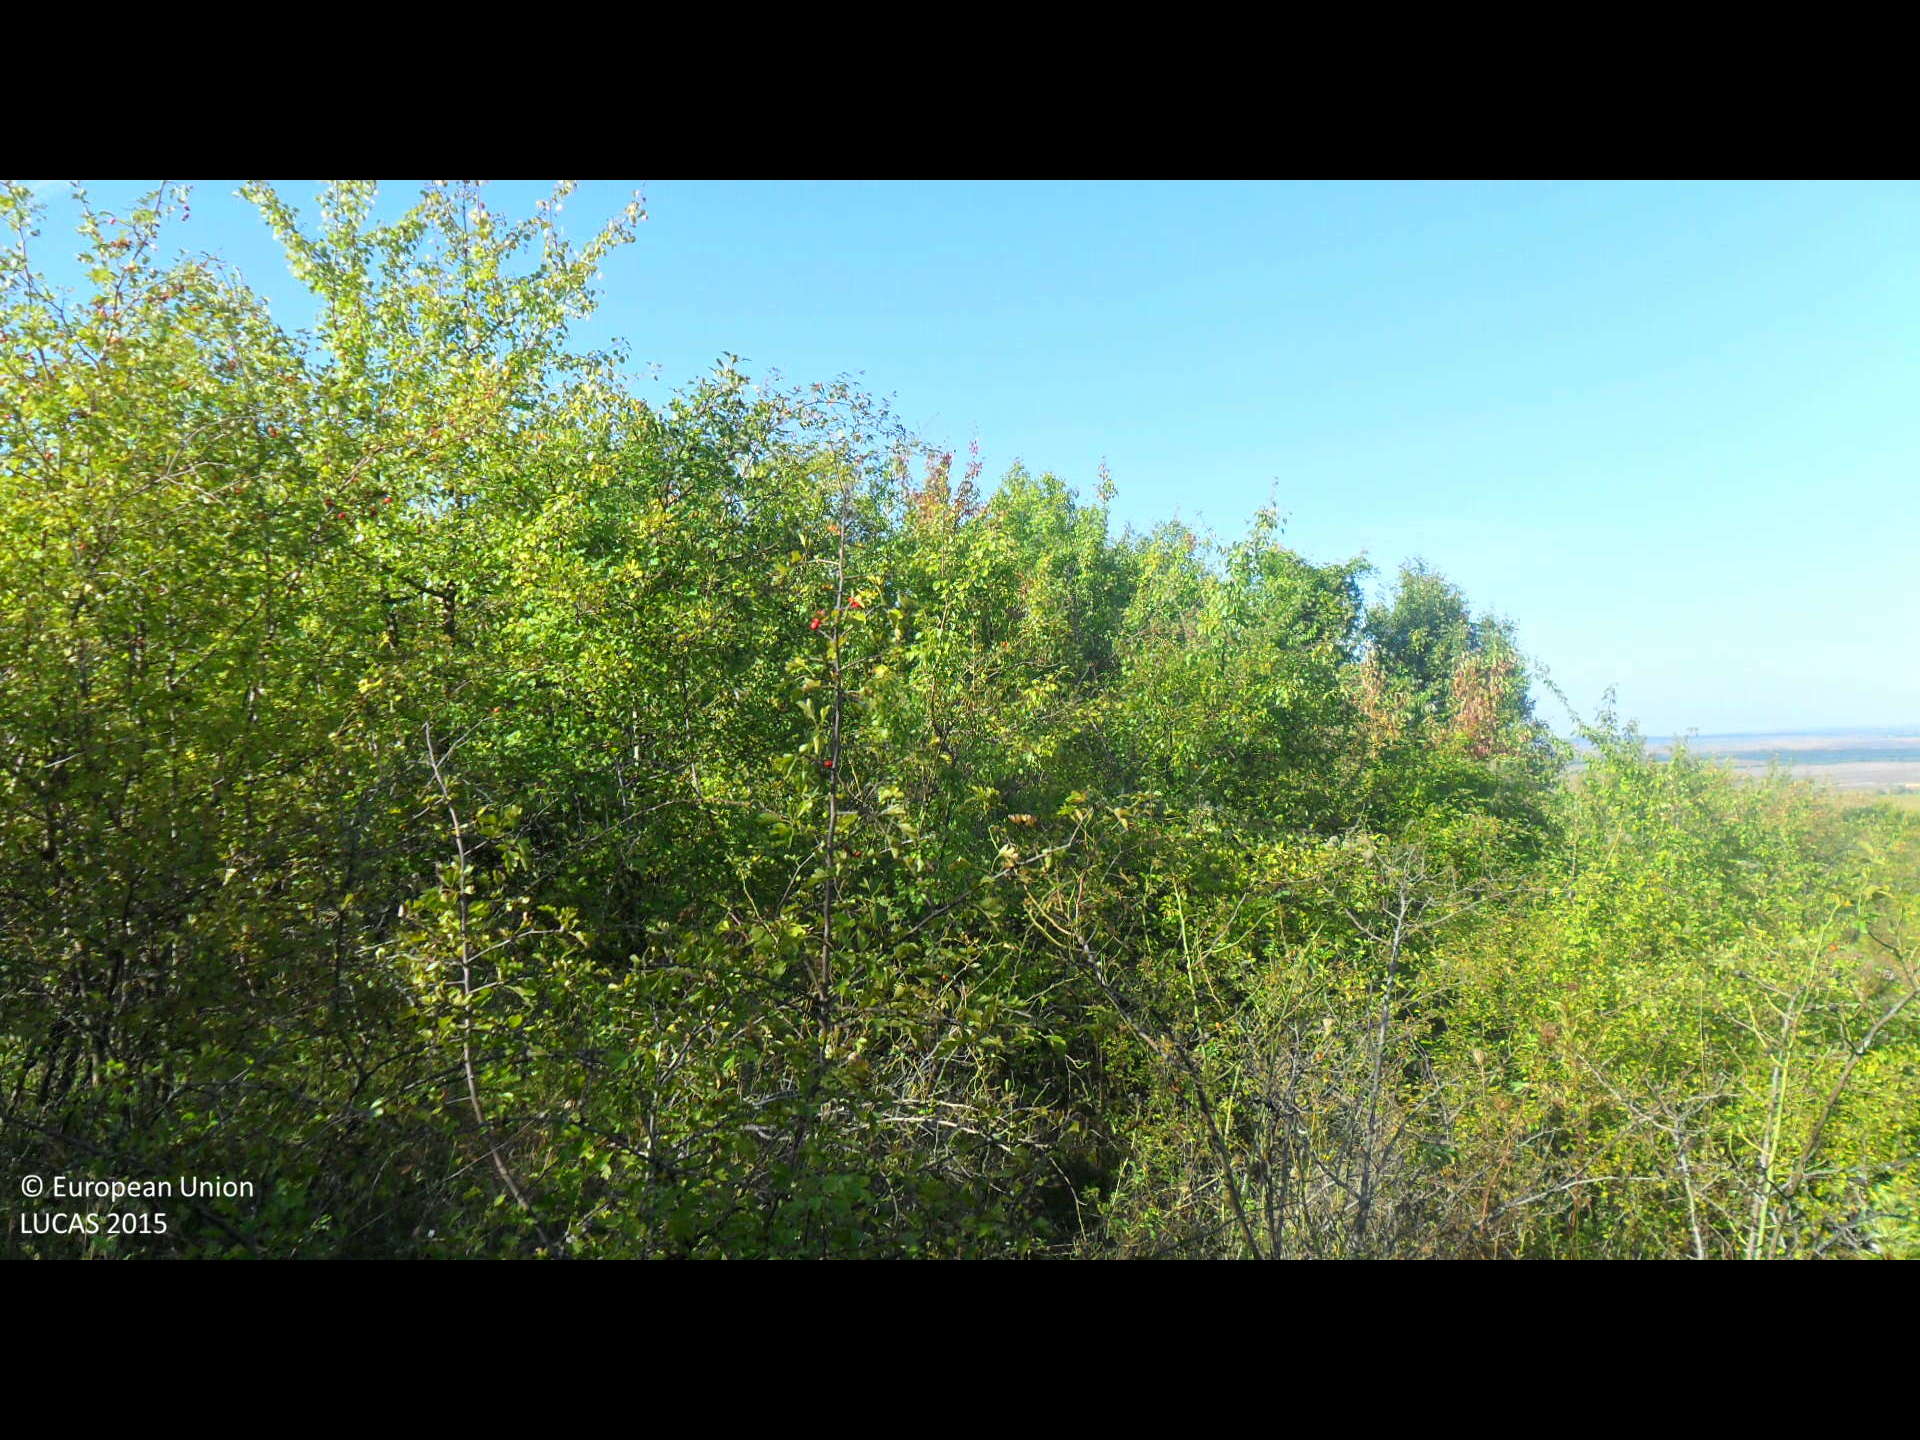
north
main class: Shrubland
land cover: Shrubland with sparse tree cover
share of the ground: > 75 %
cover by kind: shrubs 95 %, broadleaved forest trees 5 %
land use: Semi-natural and natural areas not in use
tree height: > 5 m
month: September
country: BG
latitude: 43.2580
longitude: 26.4975
